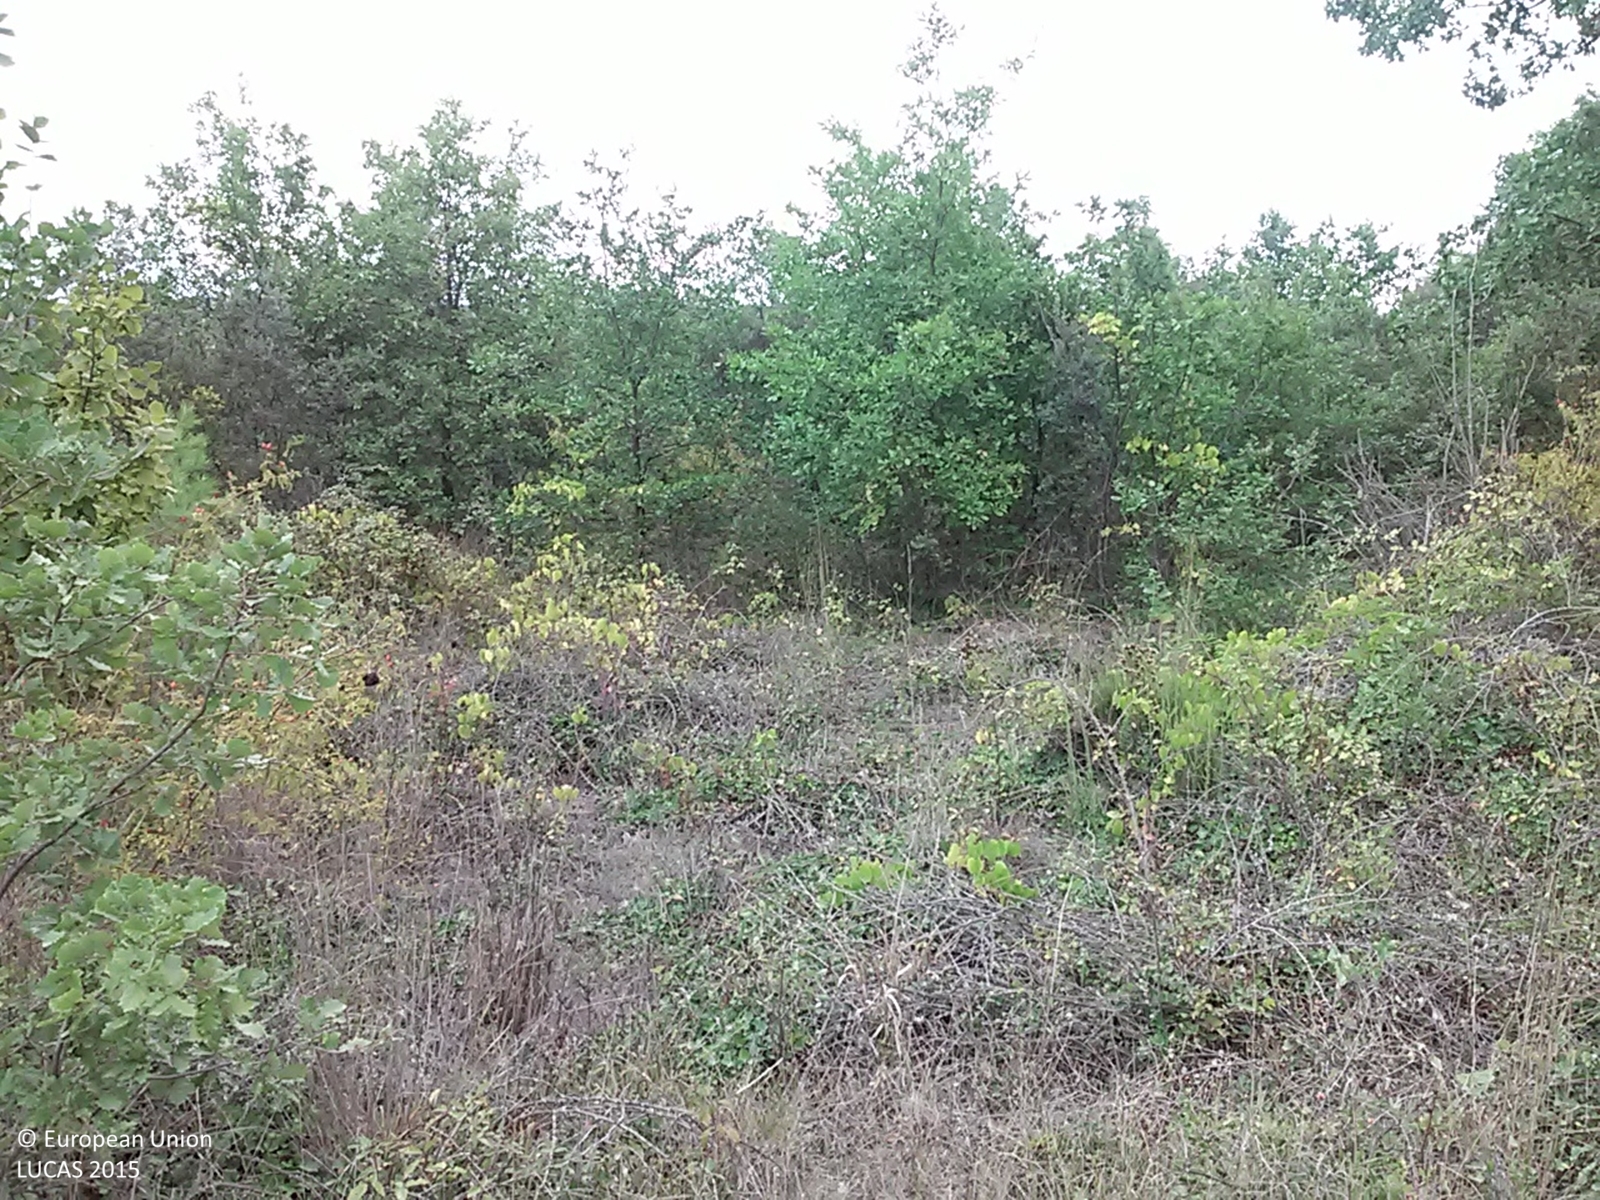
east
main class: Shrubland
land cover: Shrubland with sparse tree cover
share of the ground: 50 - 75 %
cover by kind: shrubs 65 %, herbaceous plants 30 %, coniferous forest trees 5 %
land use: Abandoned areas
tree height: < 5 m
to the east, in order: Shrubland with sparse tree cover; Broadleaved woodland; Tracks; Shrubland with sparse tree cover; Grassland with sparse tree/shrub cover; Electric lines; Shruby margins; Paved roads, cycling and walking lanes
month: September
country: ES
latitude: 41.1446
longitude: 0.8061
